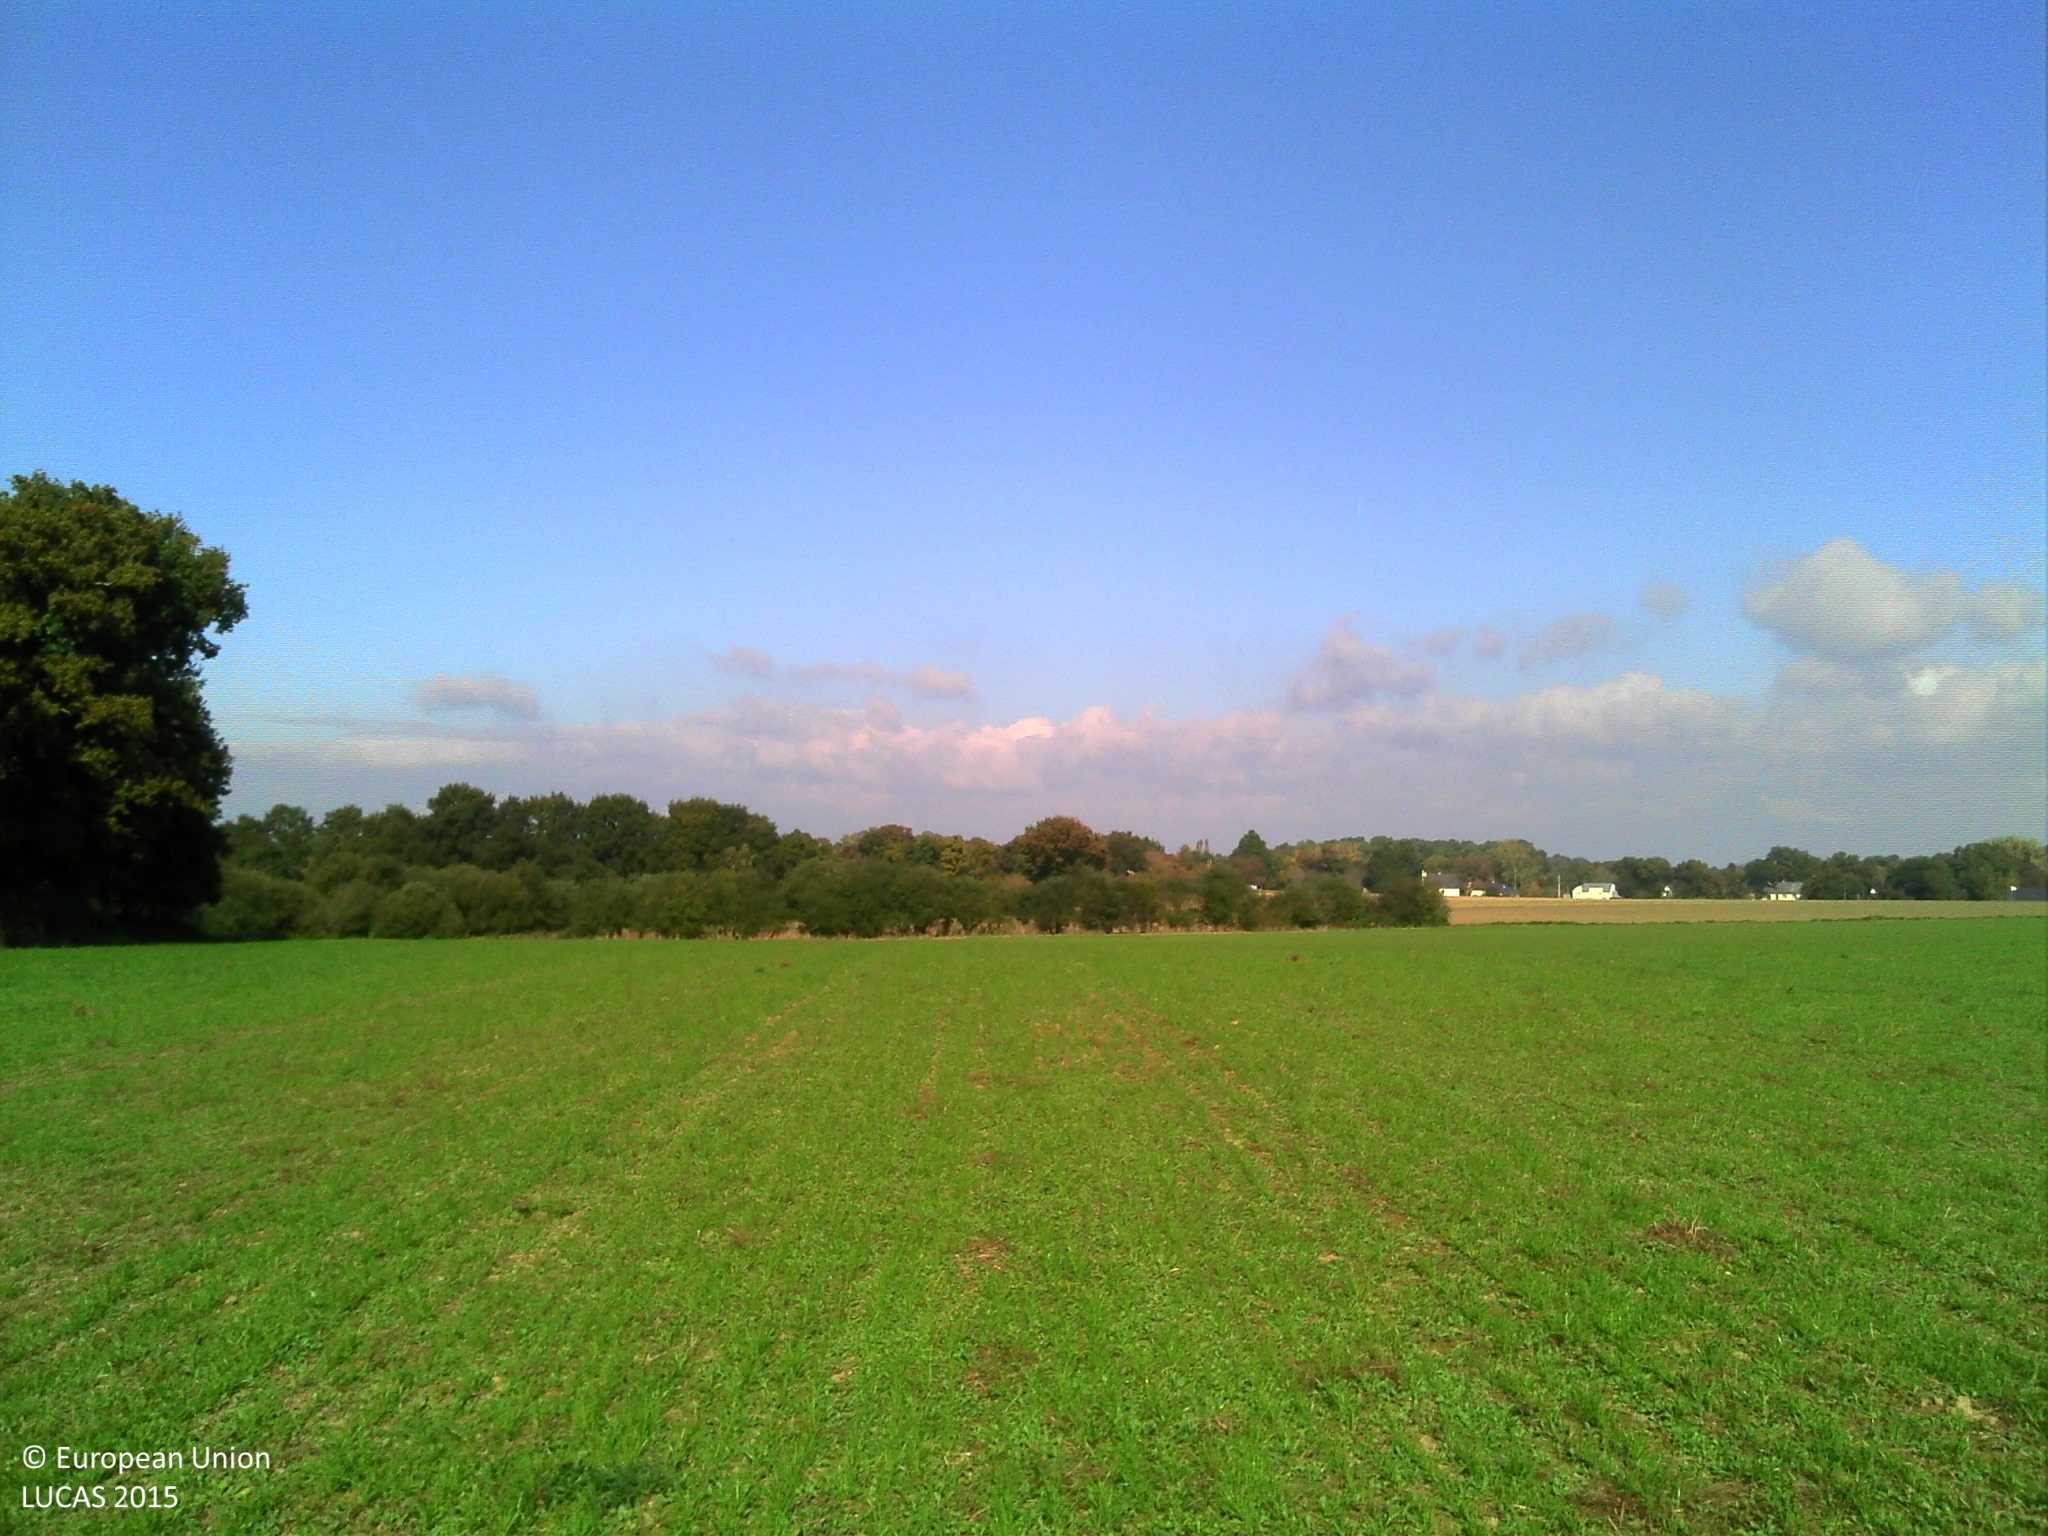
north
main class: Cropland
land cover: Temporary grasslands
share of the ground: > 75 %
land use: Agriculture (excluding fallow land and kitchen gardens)
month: October
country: FR
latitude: 47.6365
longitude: -2.1779
